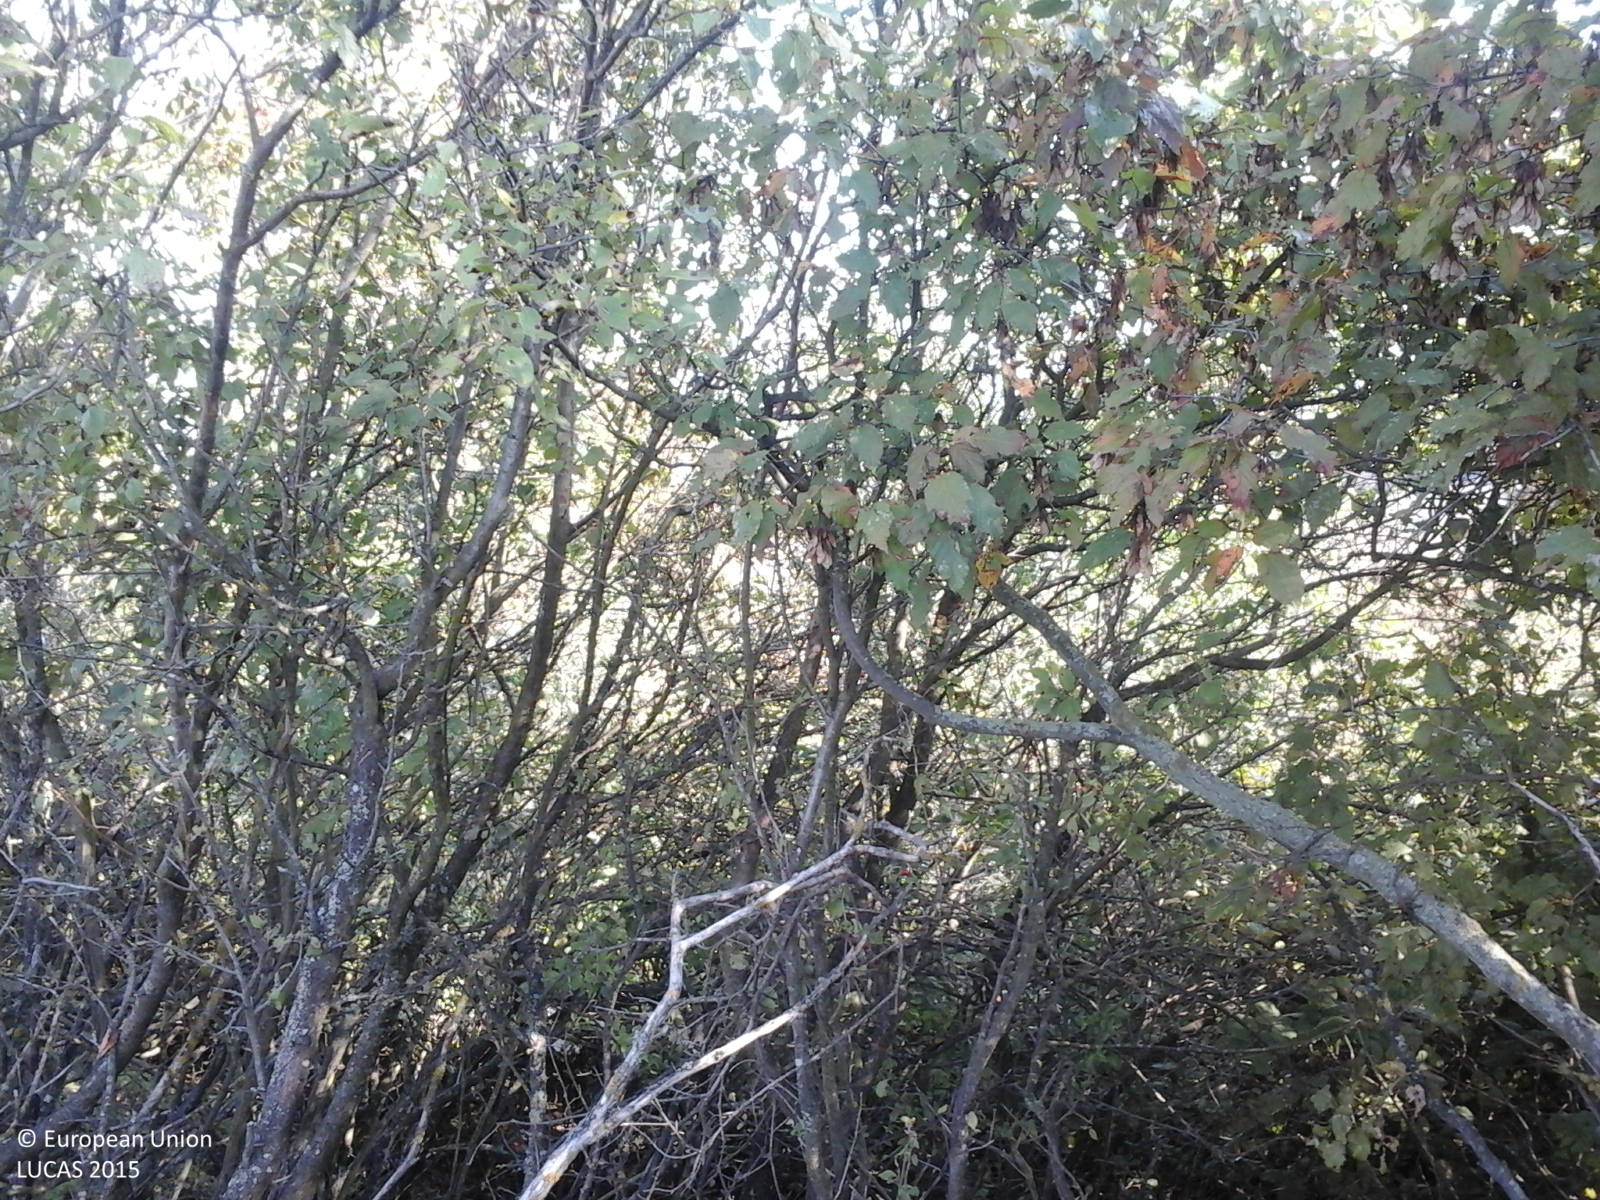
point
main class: Shrubland
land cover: Shrubland without tree cover
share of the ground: > 75 %
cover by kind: shrubs 100 %
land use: Semi-natural and natural areas not in use
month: October
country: RO
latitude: 46.3851
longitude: 23.9227
